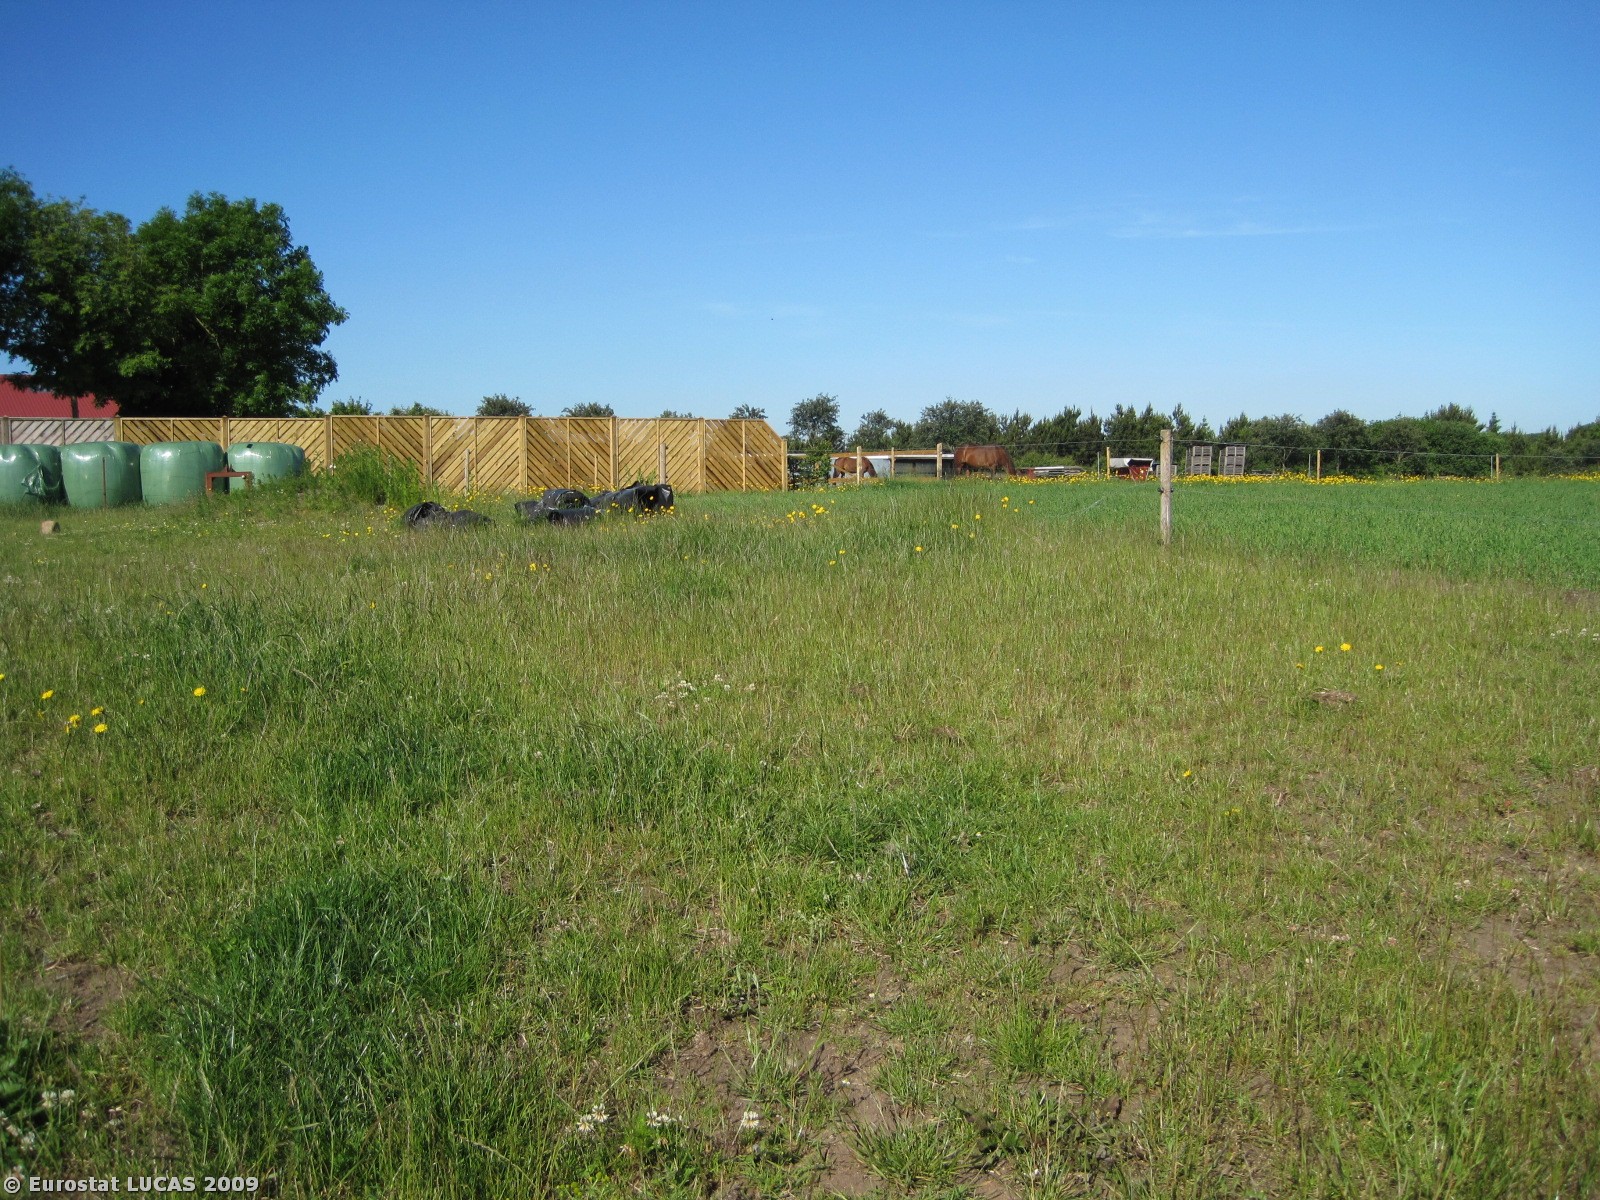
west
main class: Grassland
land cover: Grassland without tree/shrub cover
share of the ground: > 75 %
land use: Agriculture (excluding fallow land and kitchen gardens)
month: June
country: DK
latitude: 56.5448
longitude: 9.2041
